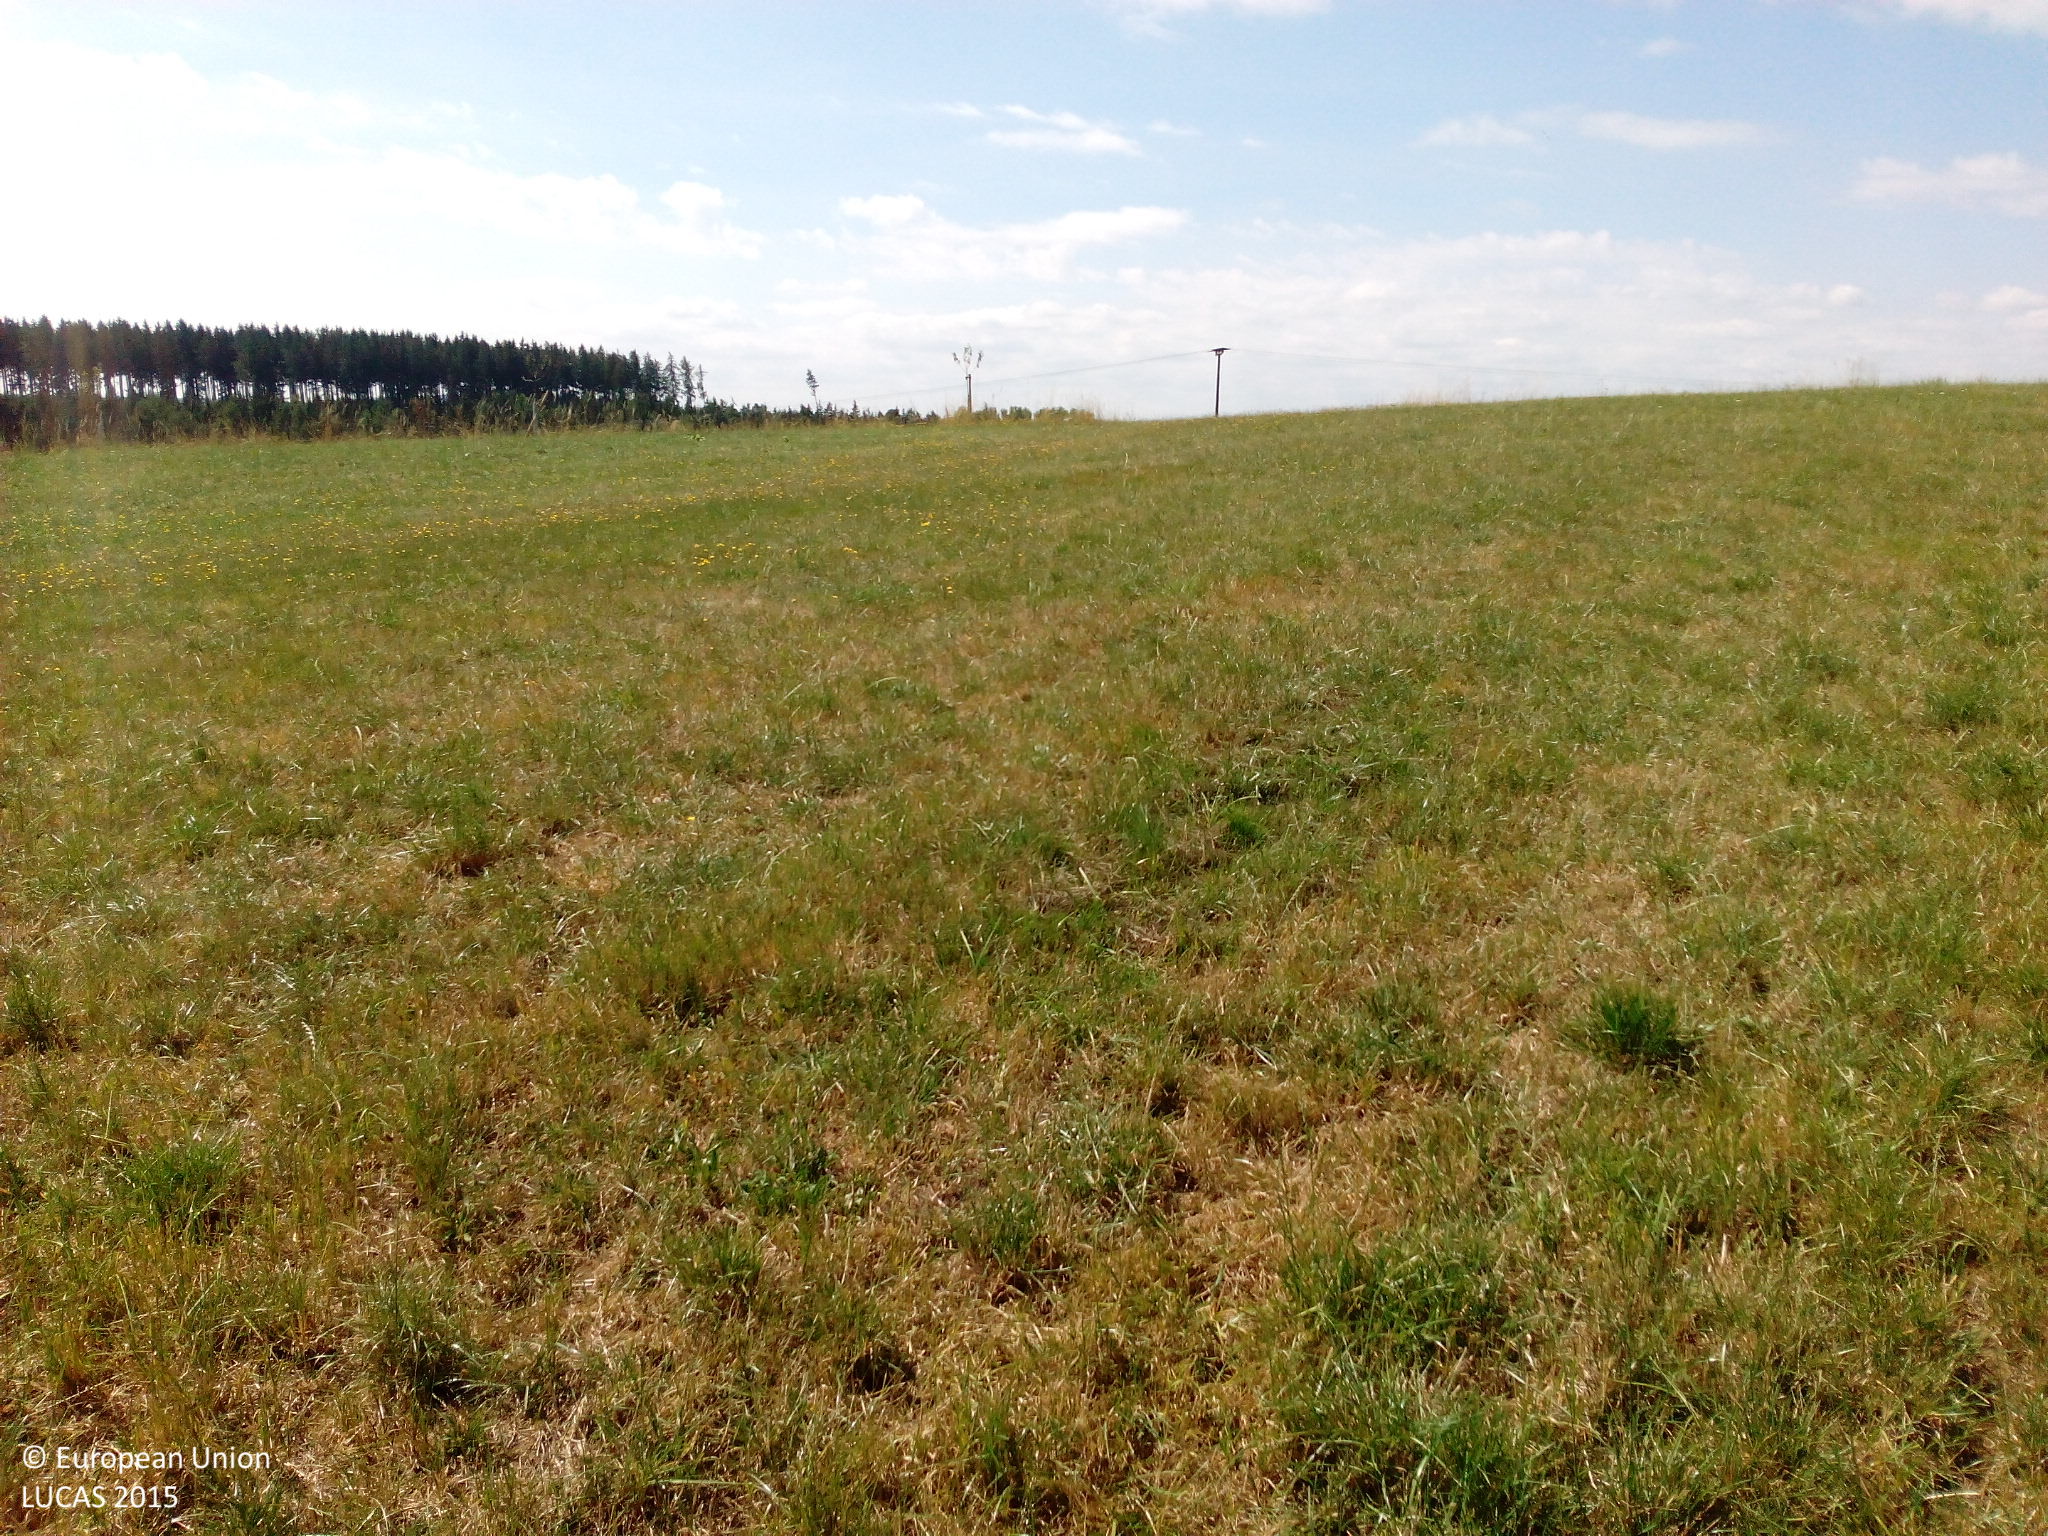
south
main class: Grassland
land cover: Grassland without tree/shrub cover
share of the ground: > 75 %
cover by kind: herbaceous plants 90 %, unconsolidated bare surface 10 %
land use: Agriculture (excluding fallow land and kitchen gardens)
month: August
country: DE
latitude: 48.9789
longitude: 10.2595
